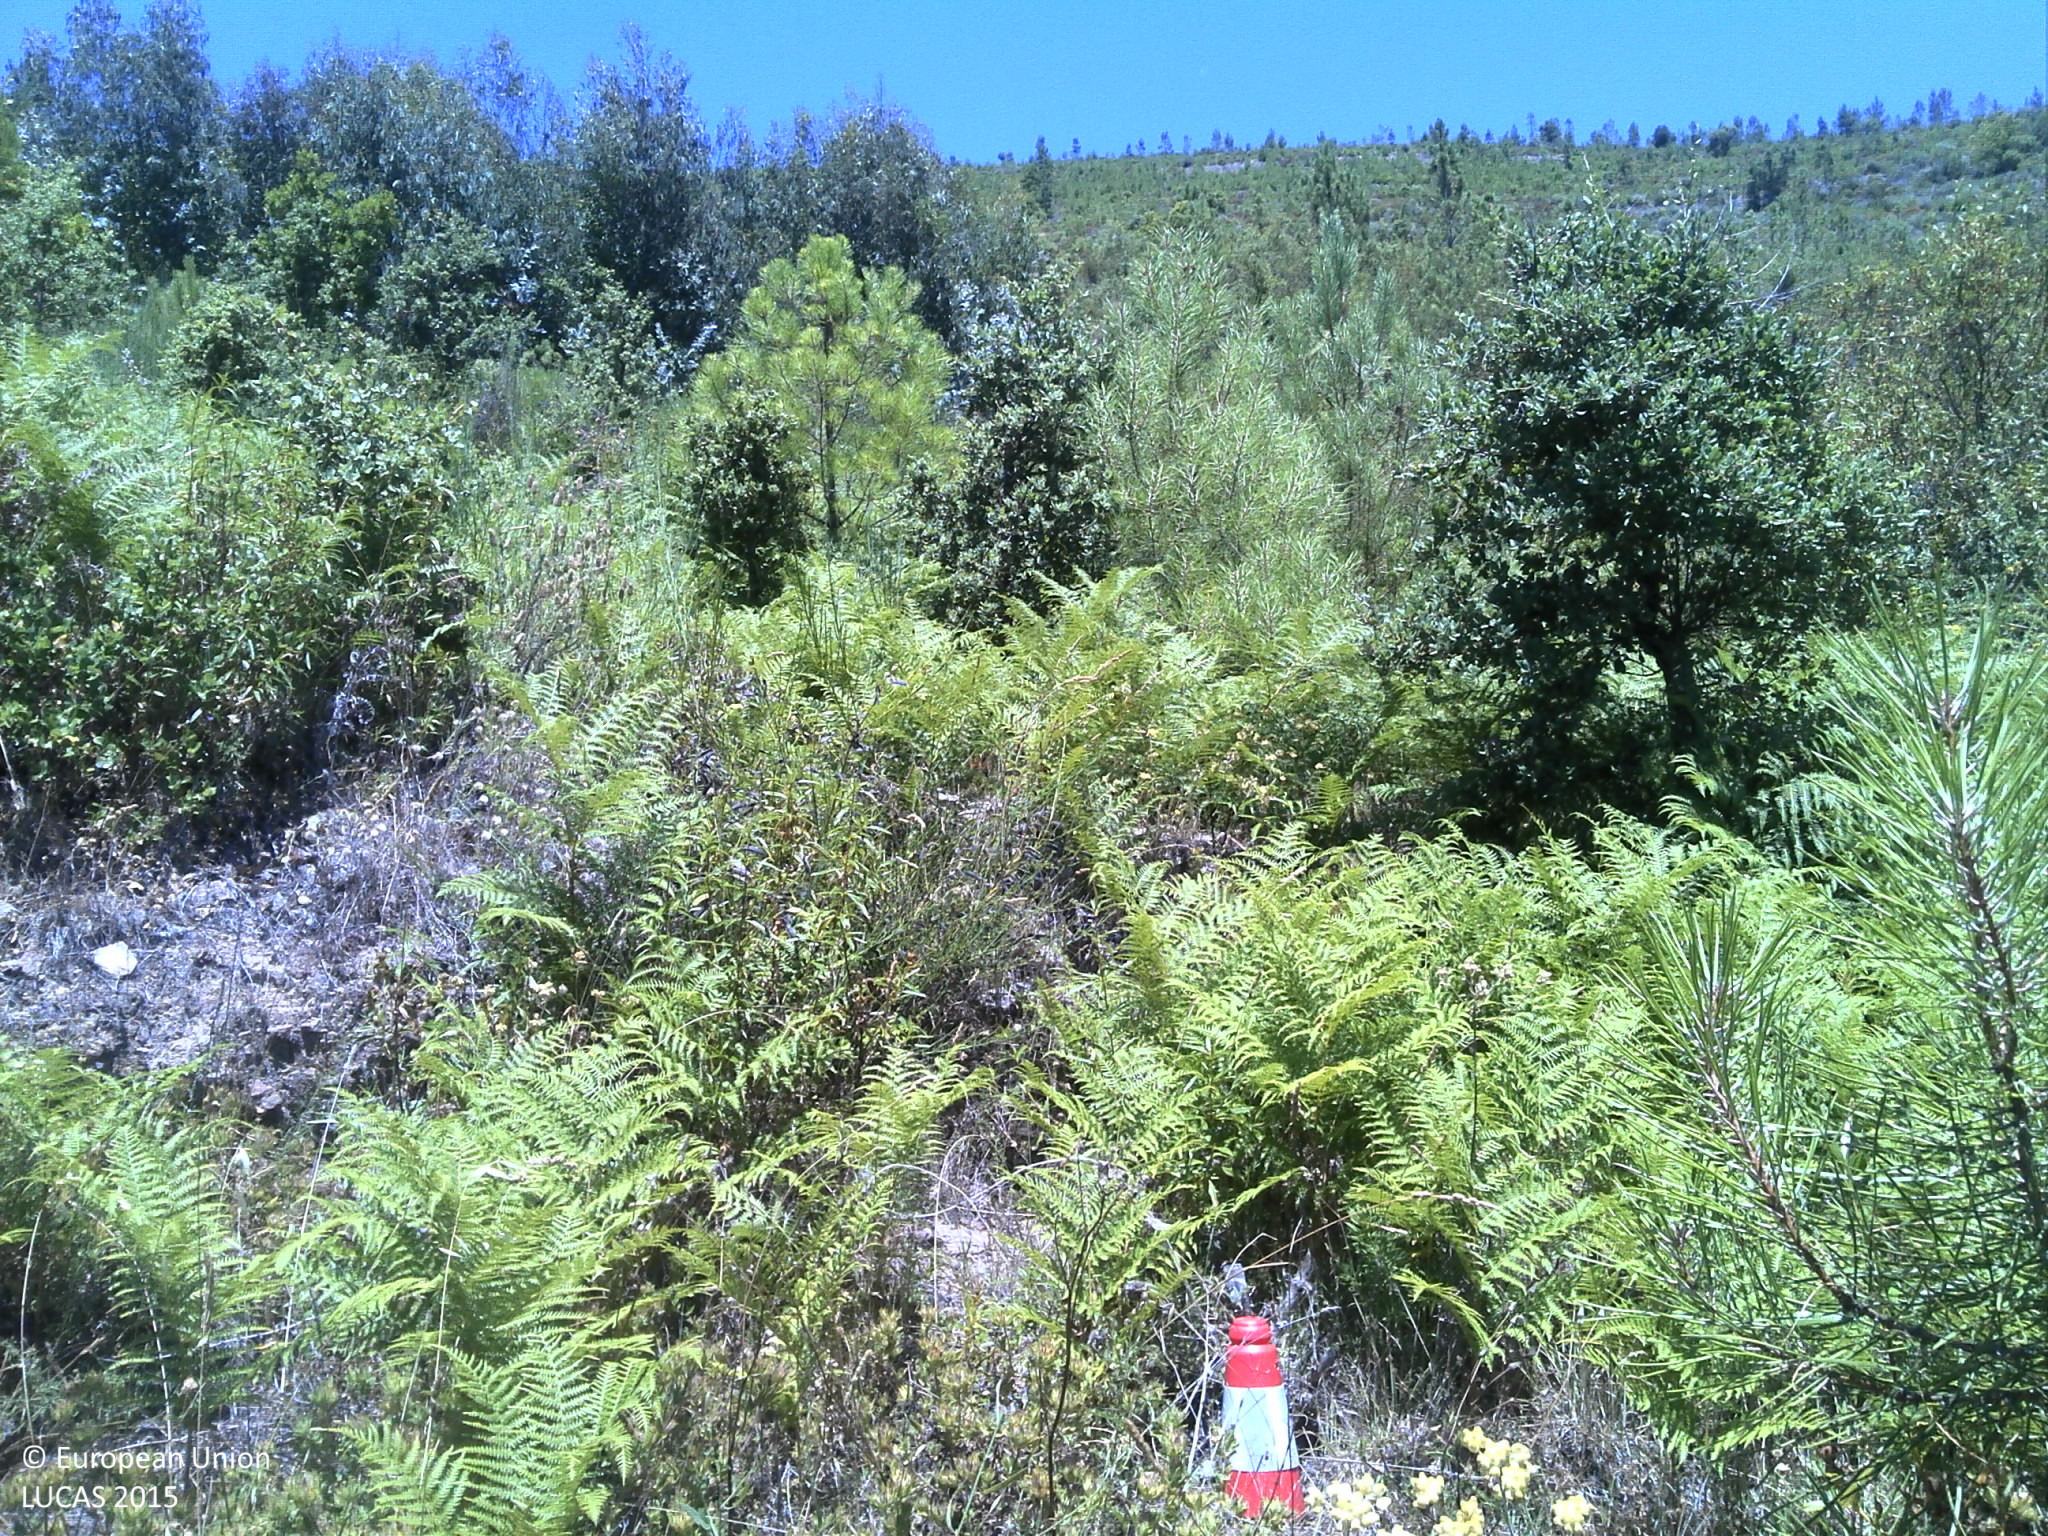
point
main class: Woodland
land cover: Broadleaved woodland
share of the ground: 25 - 50 %
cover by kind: broadleaved forest trees 45 %, shrubs 35 %, herbaceous plants 5 %, lichens and mosses 5 %, unconsolidated bare surface 5 %
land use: Forestry
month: June
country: PT
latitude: 40.1183
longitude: -7.4092
